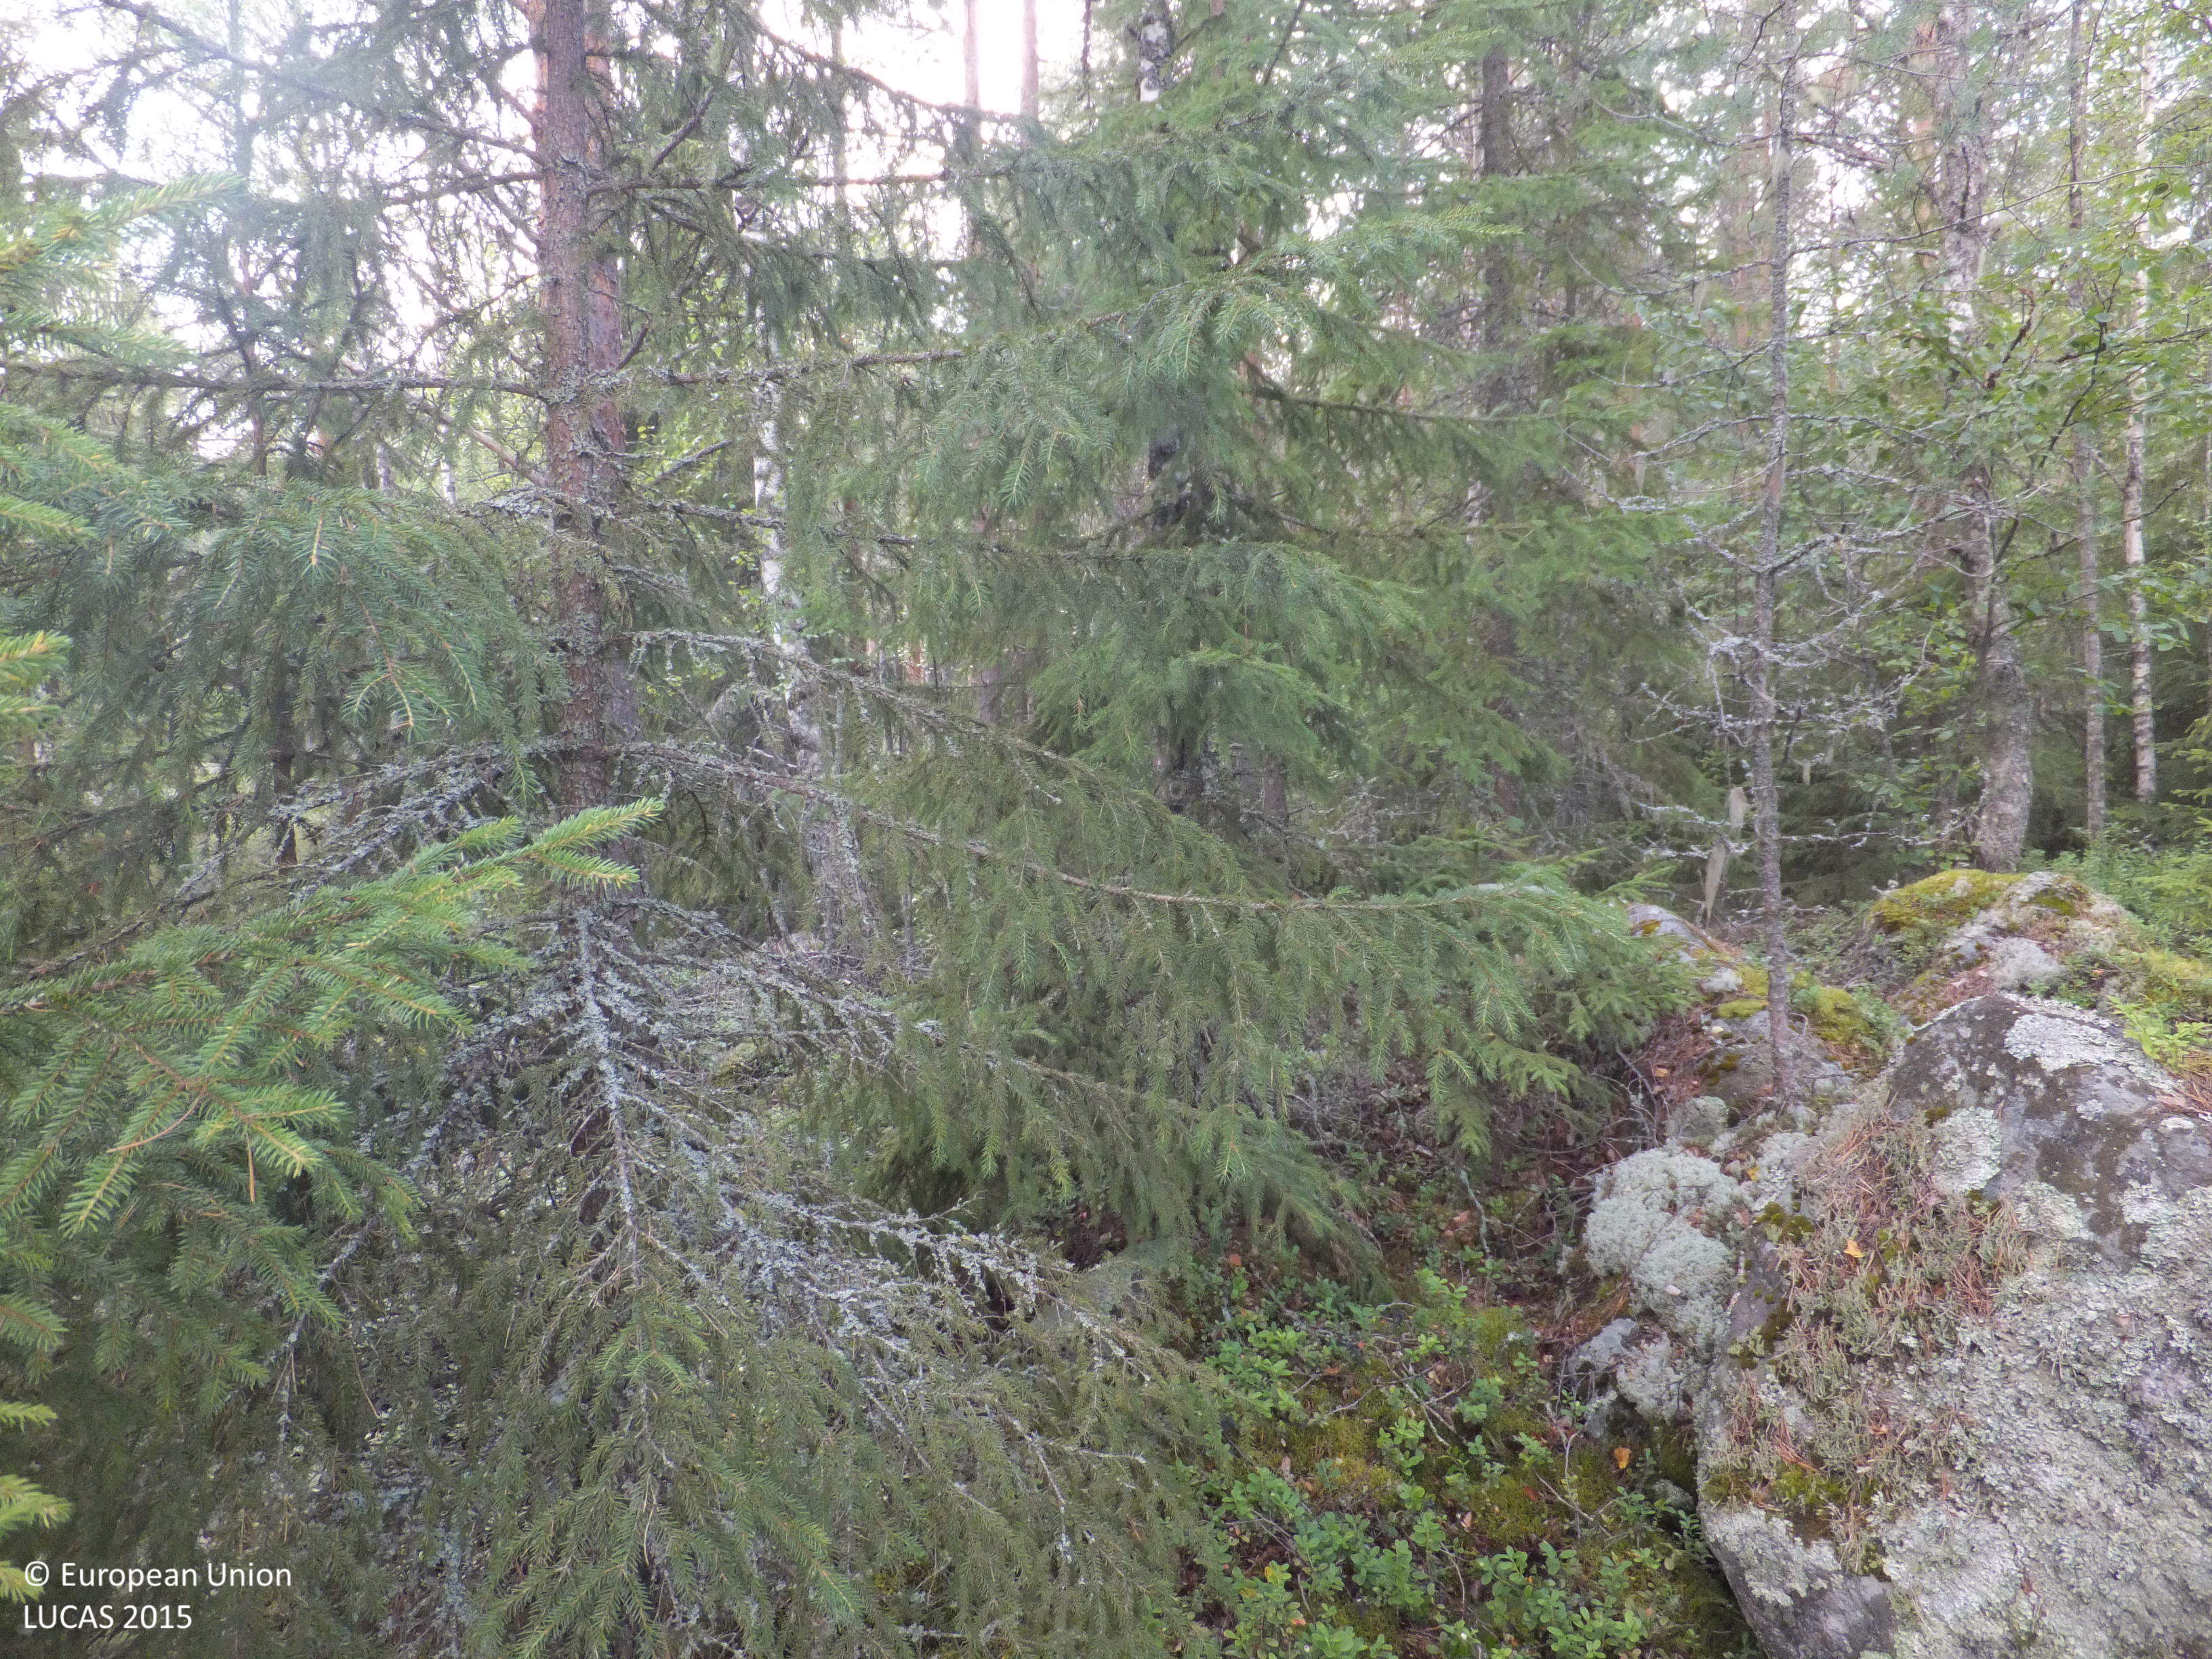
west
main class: Woodland
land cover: Other mixed woodland
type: boreal forest
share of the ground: 50 - 75 %
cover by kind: coniferous forest trees 30 %, broadleaved forest trees 30 %, shrubs 15 %, lichens and mosses 15 %, consolidated bare surface 10 %
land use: Forestry
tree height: > 5 m
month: July
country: FI
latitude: 63.2296
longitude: 22.2047
